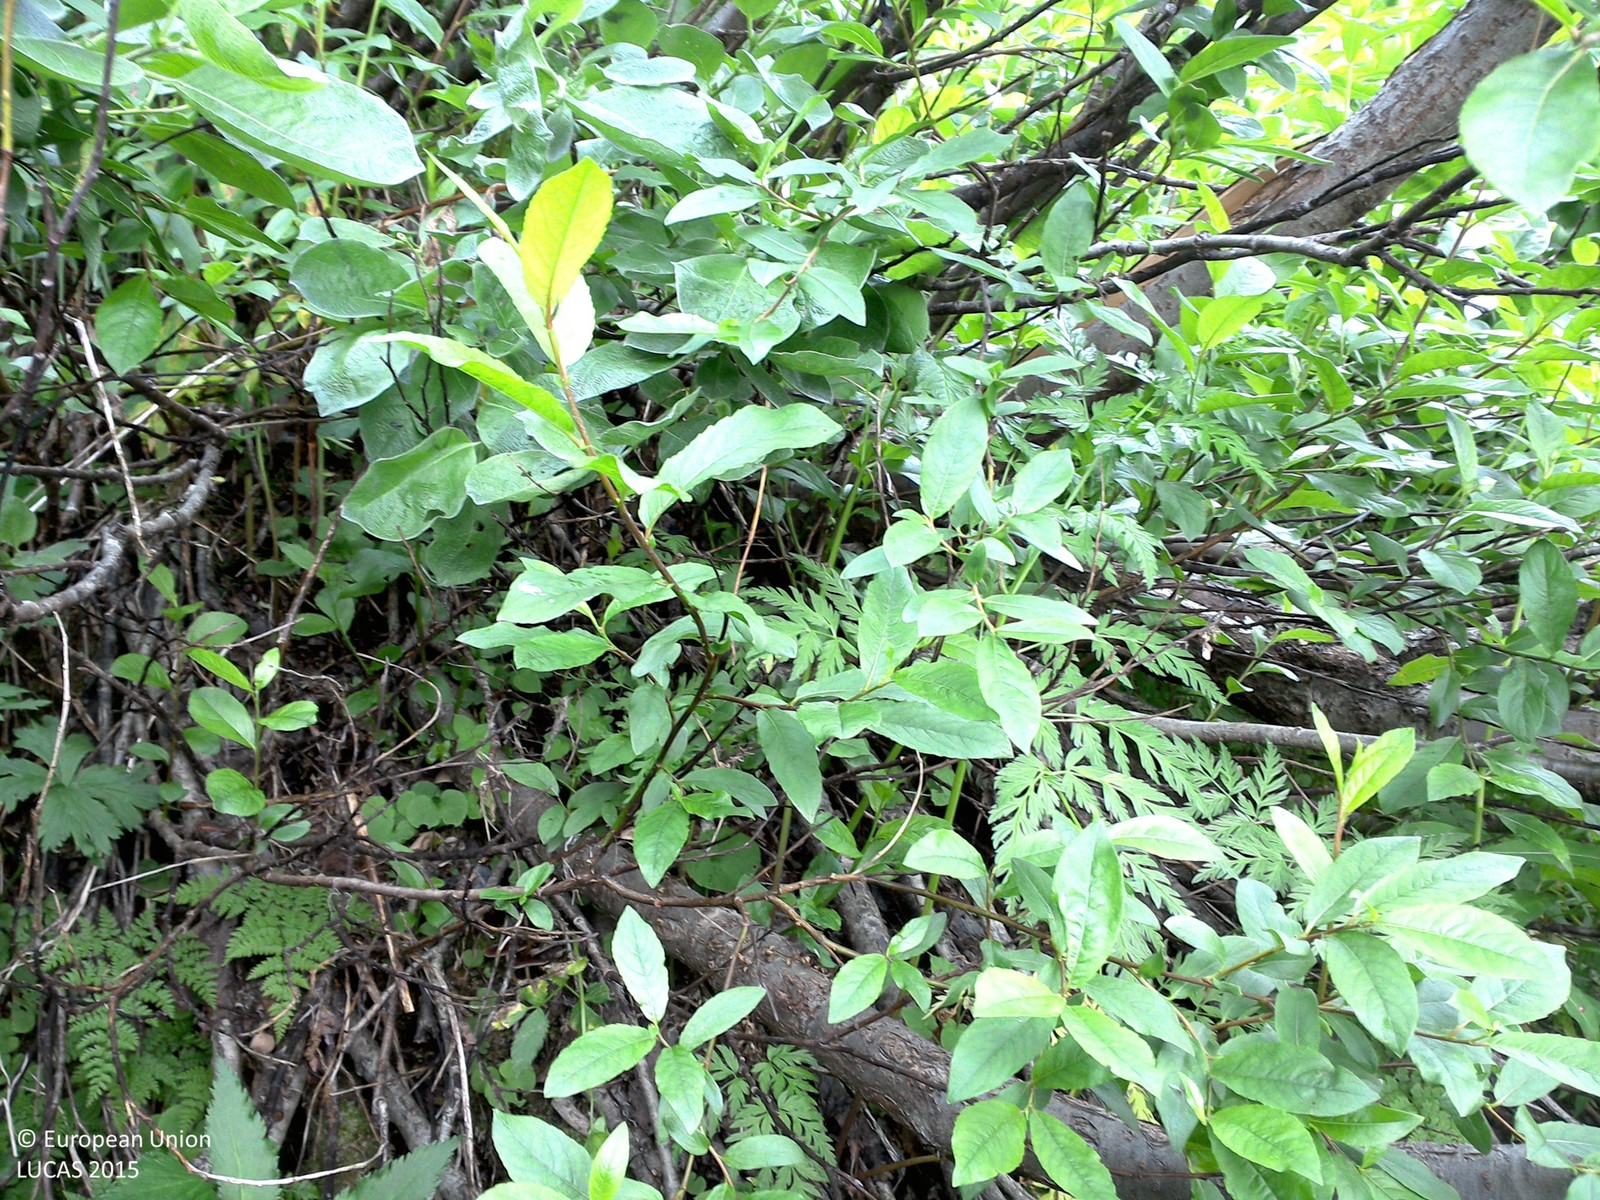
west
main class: Woodland
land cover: Broadleaved woodland
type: non-riverine alder, birch or aspen forest
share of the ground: > 75 %
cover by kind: broadleaved forest trees 90 %, shrubs 10 %
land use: Semi-natural and natural areas not in use
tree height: < 5 m
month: August
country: SE
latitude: 68.3866
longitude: 18.7139
